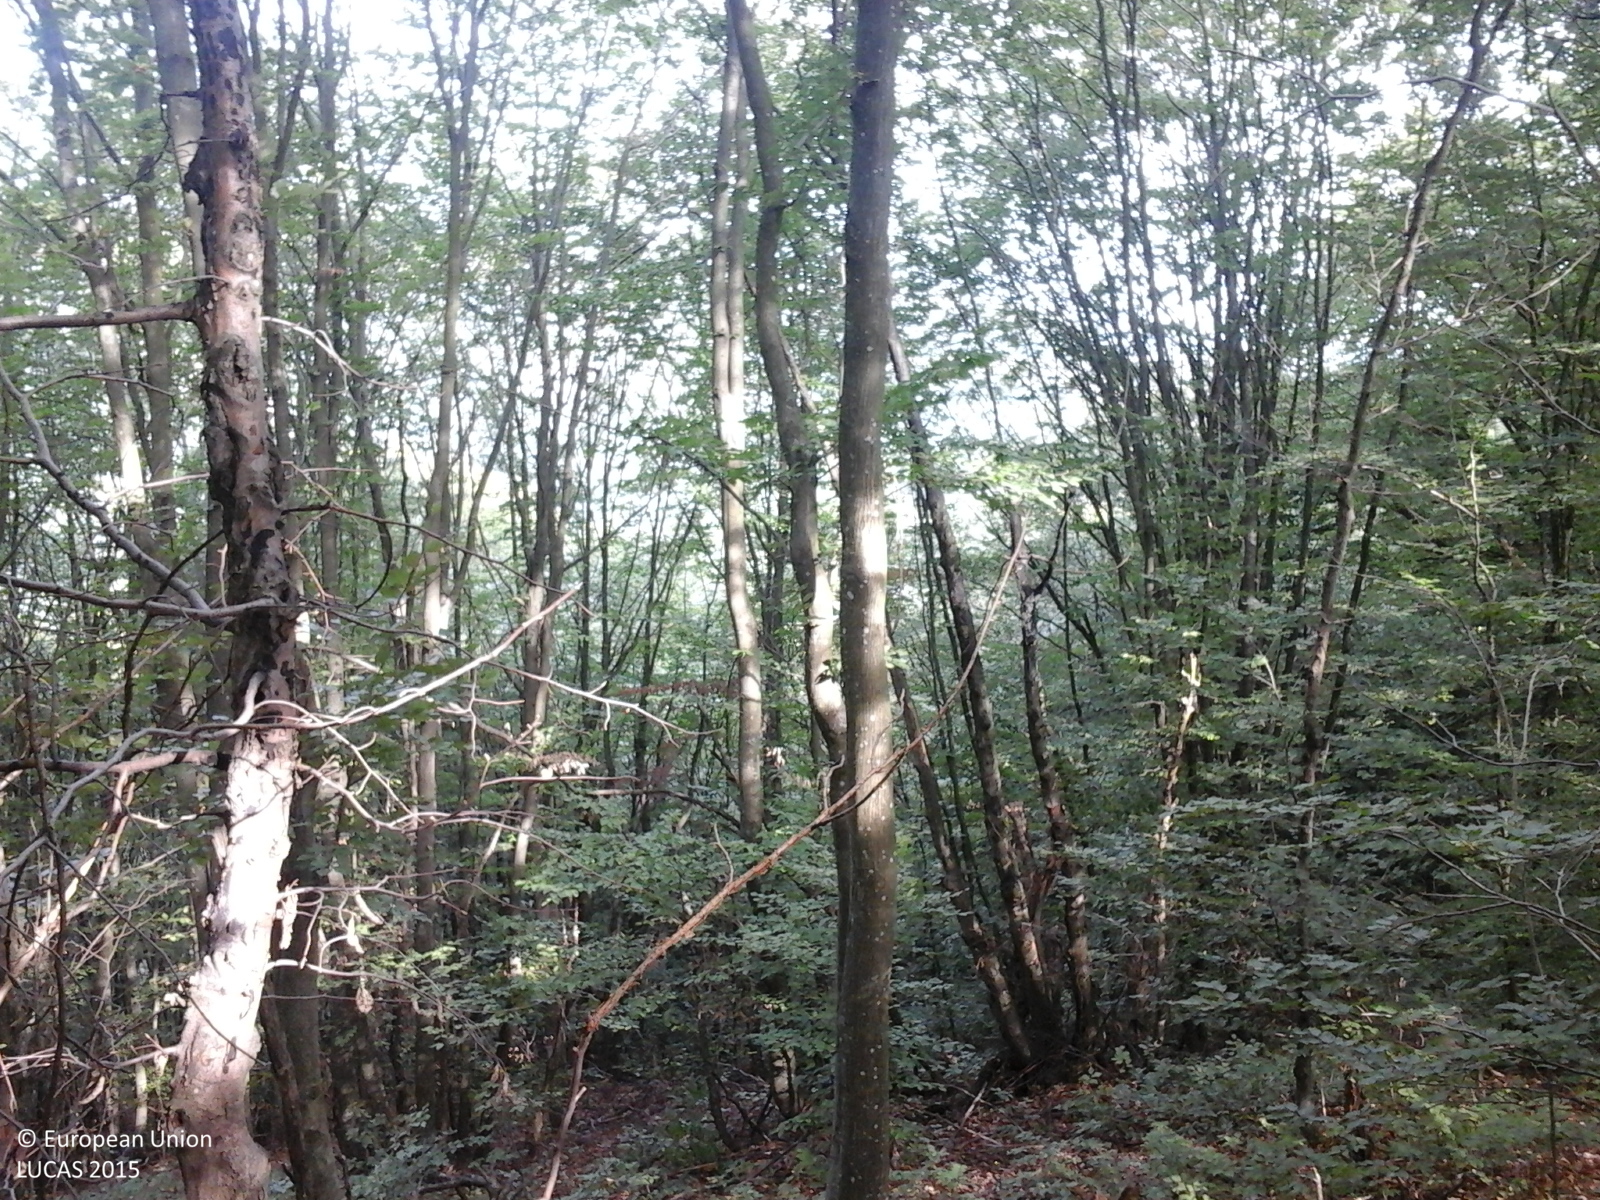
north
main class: Woodland
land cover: Broadleaved woodland
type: mesophytic deciduous forest
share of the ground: > 75 %
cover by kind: broadleaved forest trees 100 %
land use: Forestry
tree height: > 5 m
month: September
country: RO
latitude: 47.2118
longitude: 23.7420
